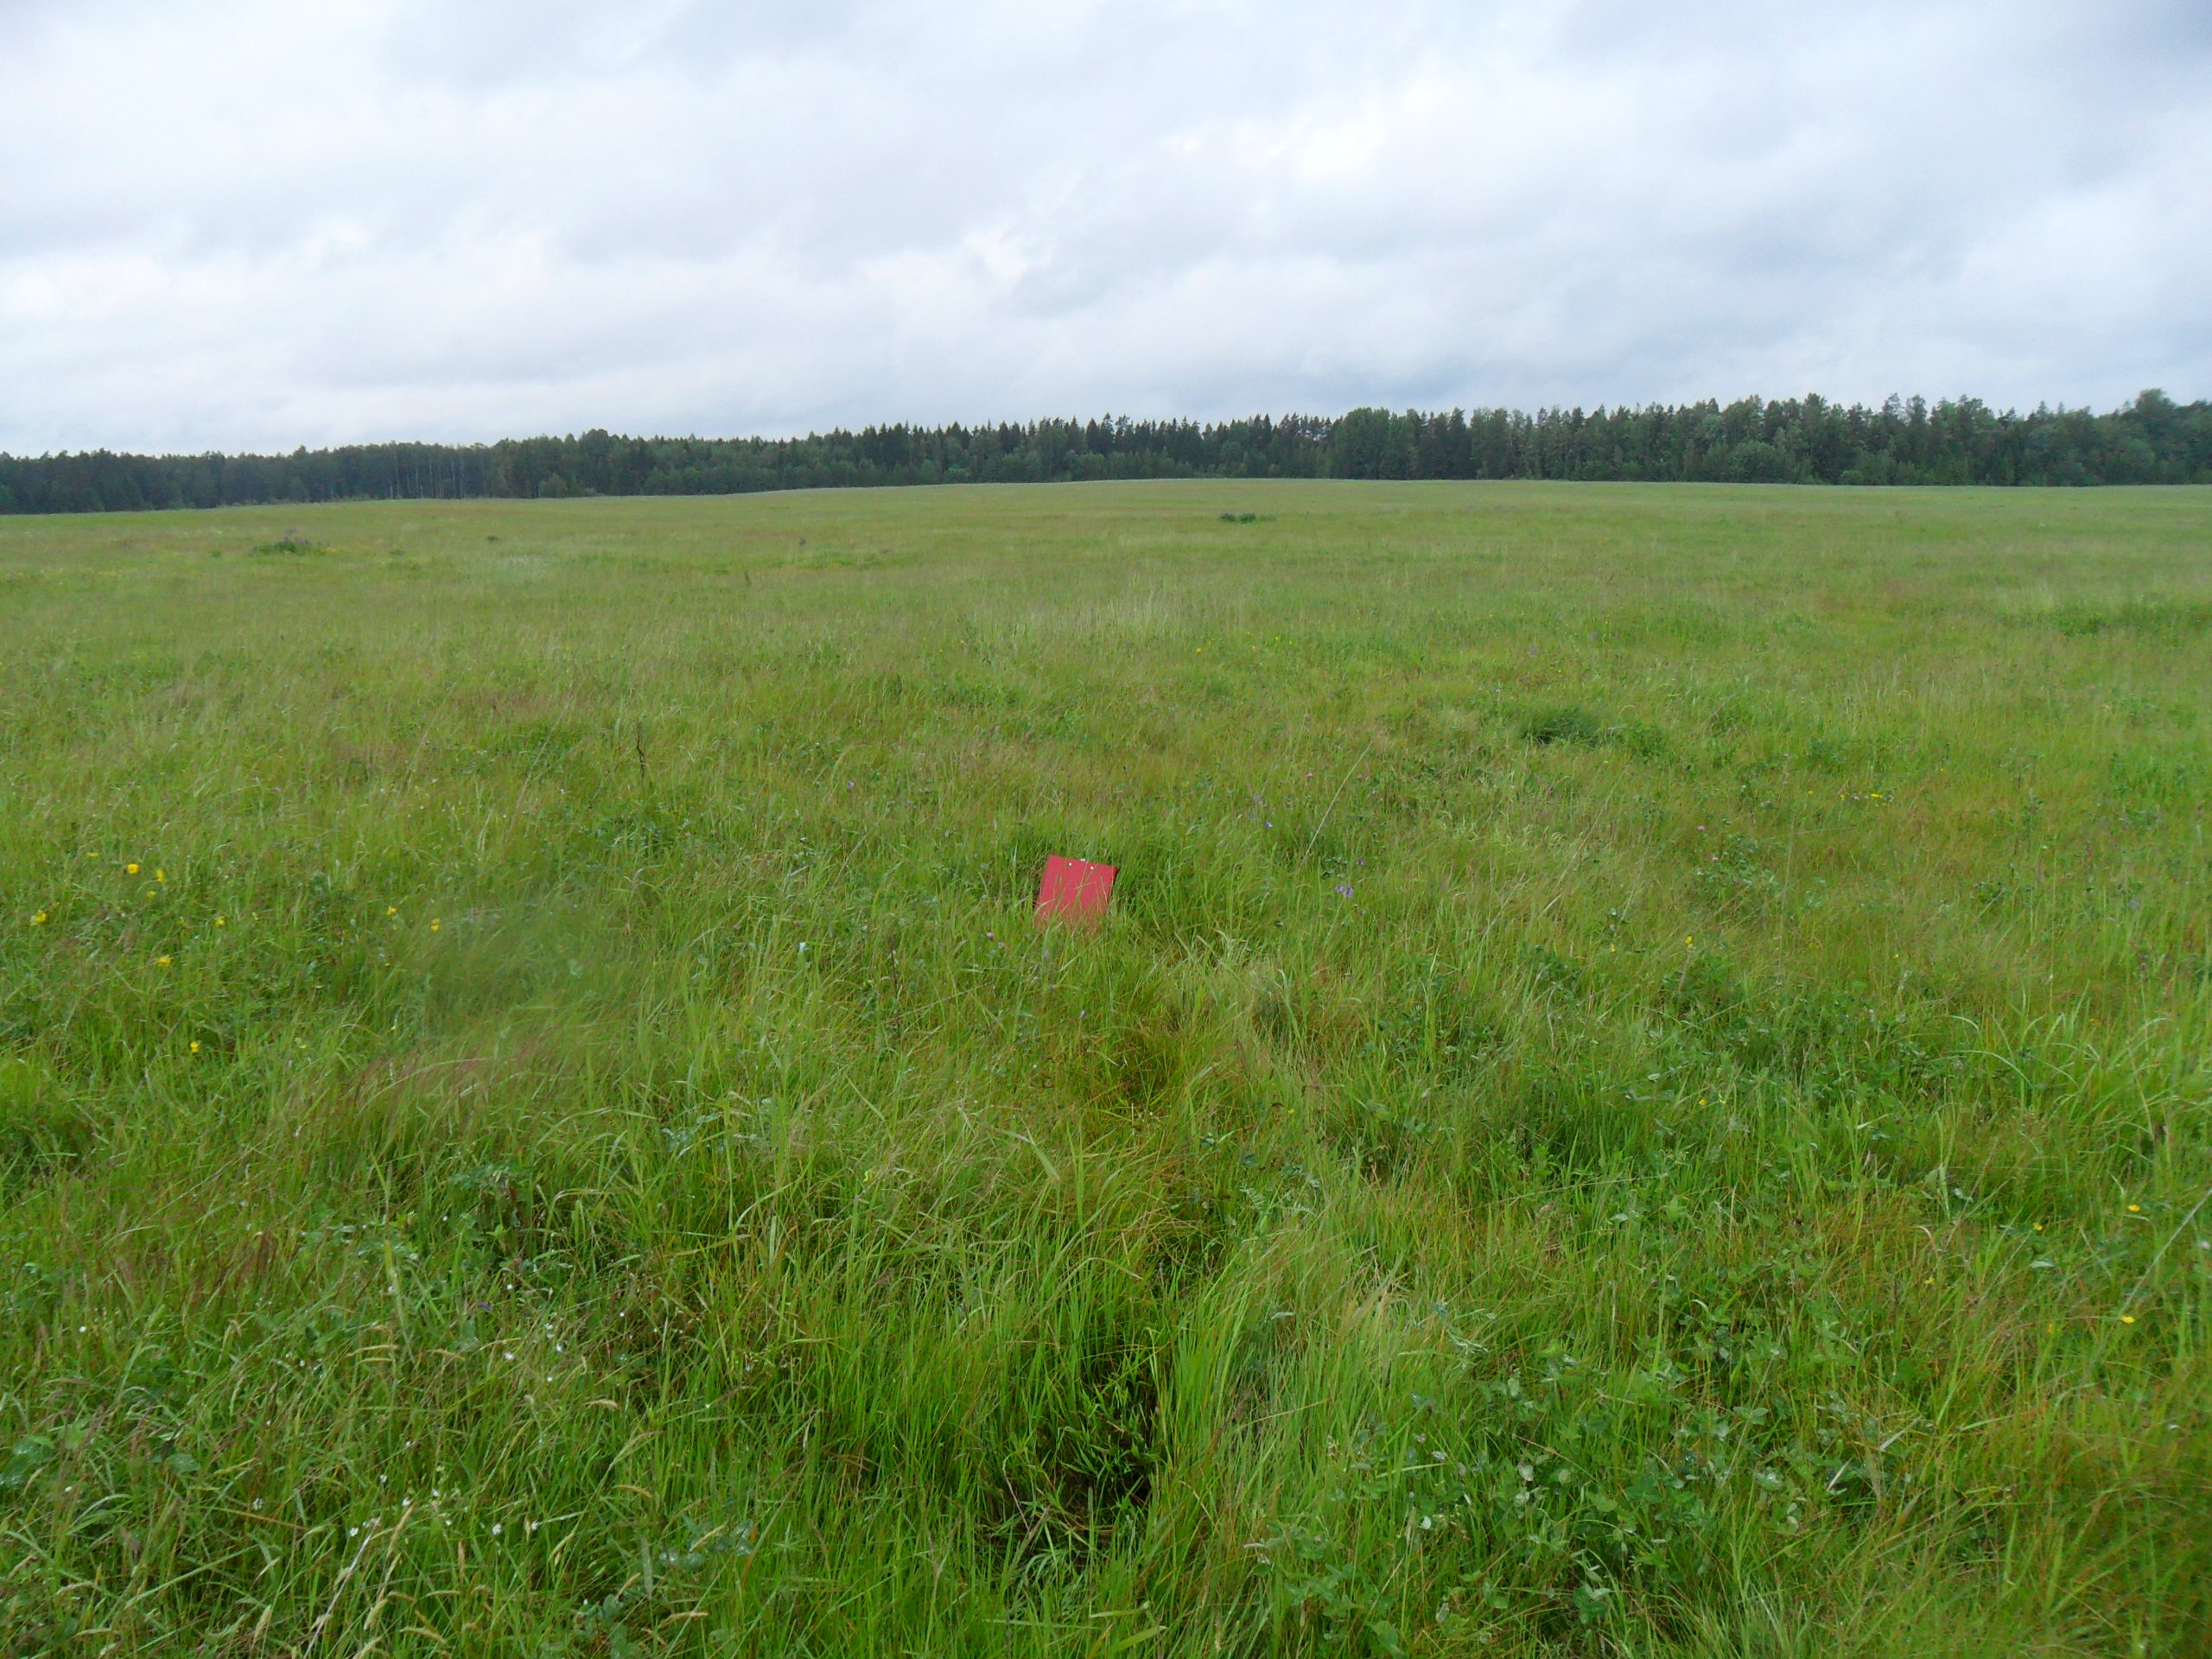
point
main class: Grassland
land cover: Grassland without tree/shrub cover
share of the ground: > 75 %
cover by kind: herbaceous plants 100 %
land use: Agriculture (excluding fallow land and kitchen gardens)
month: June
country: LV
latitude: 57.2839
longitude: 22.1418
